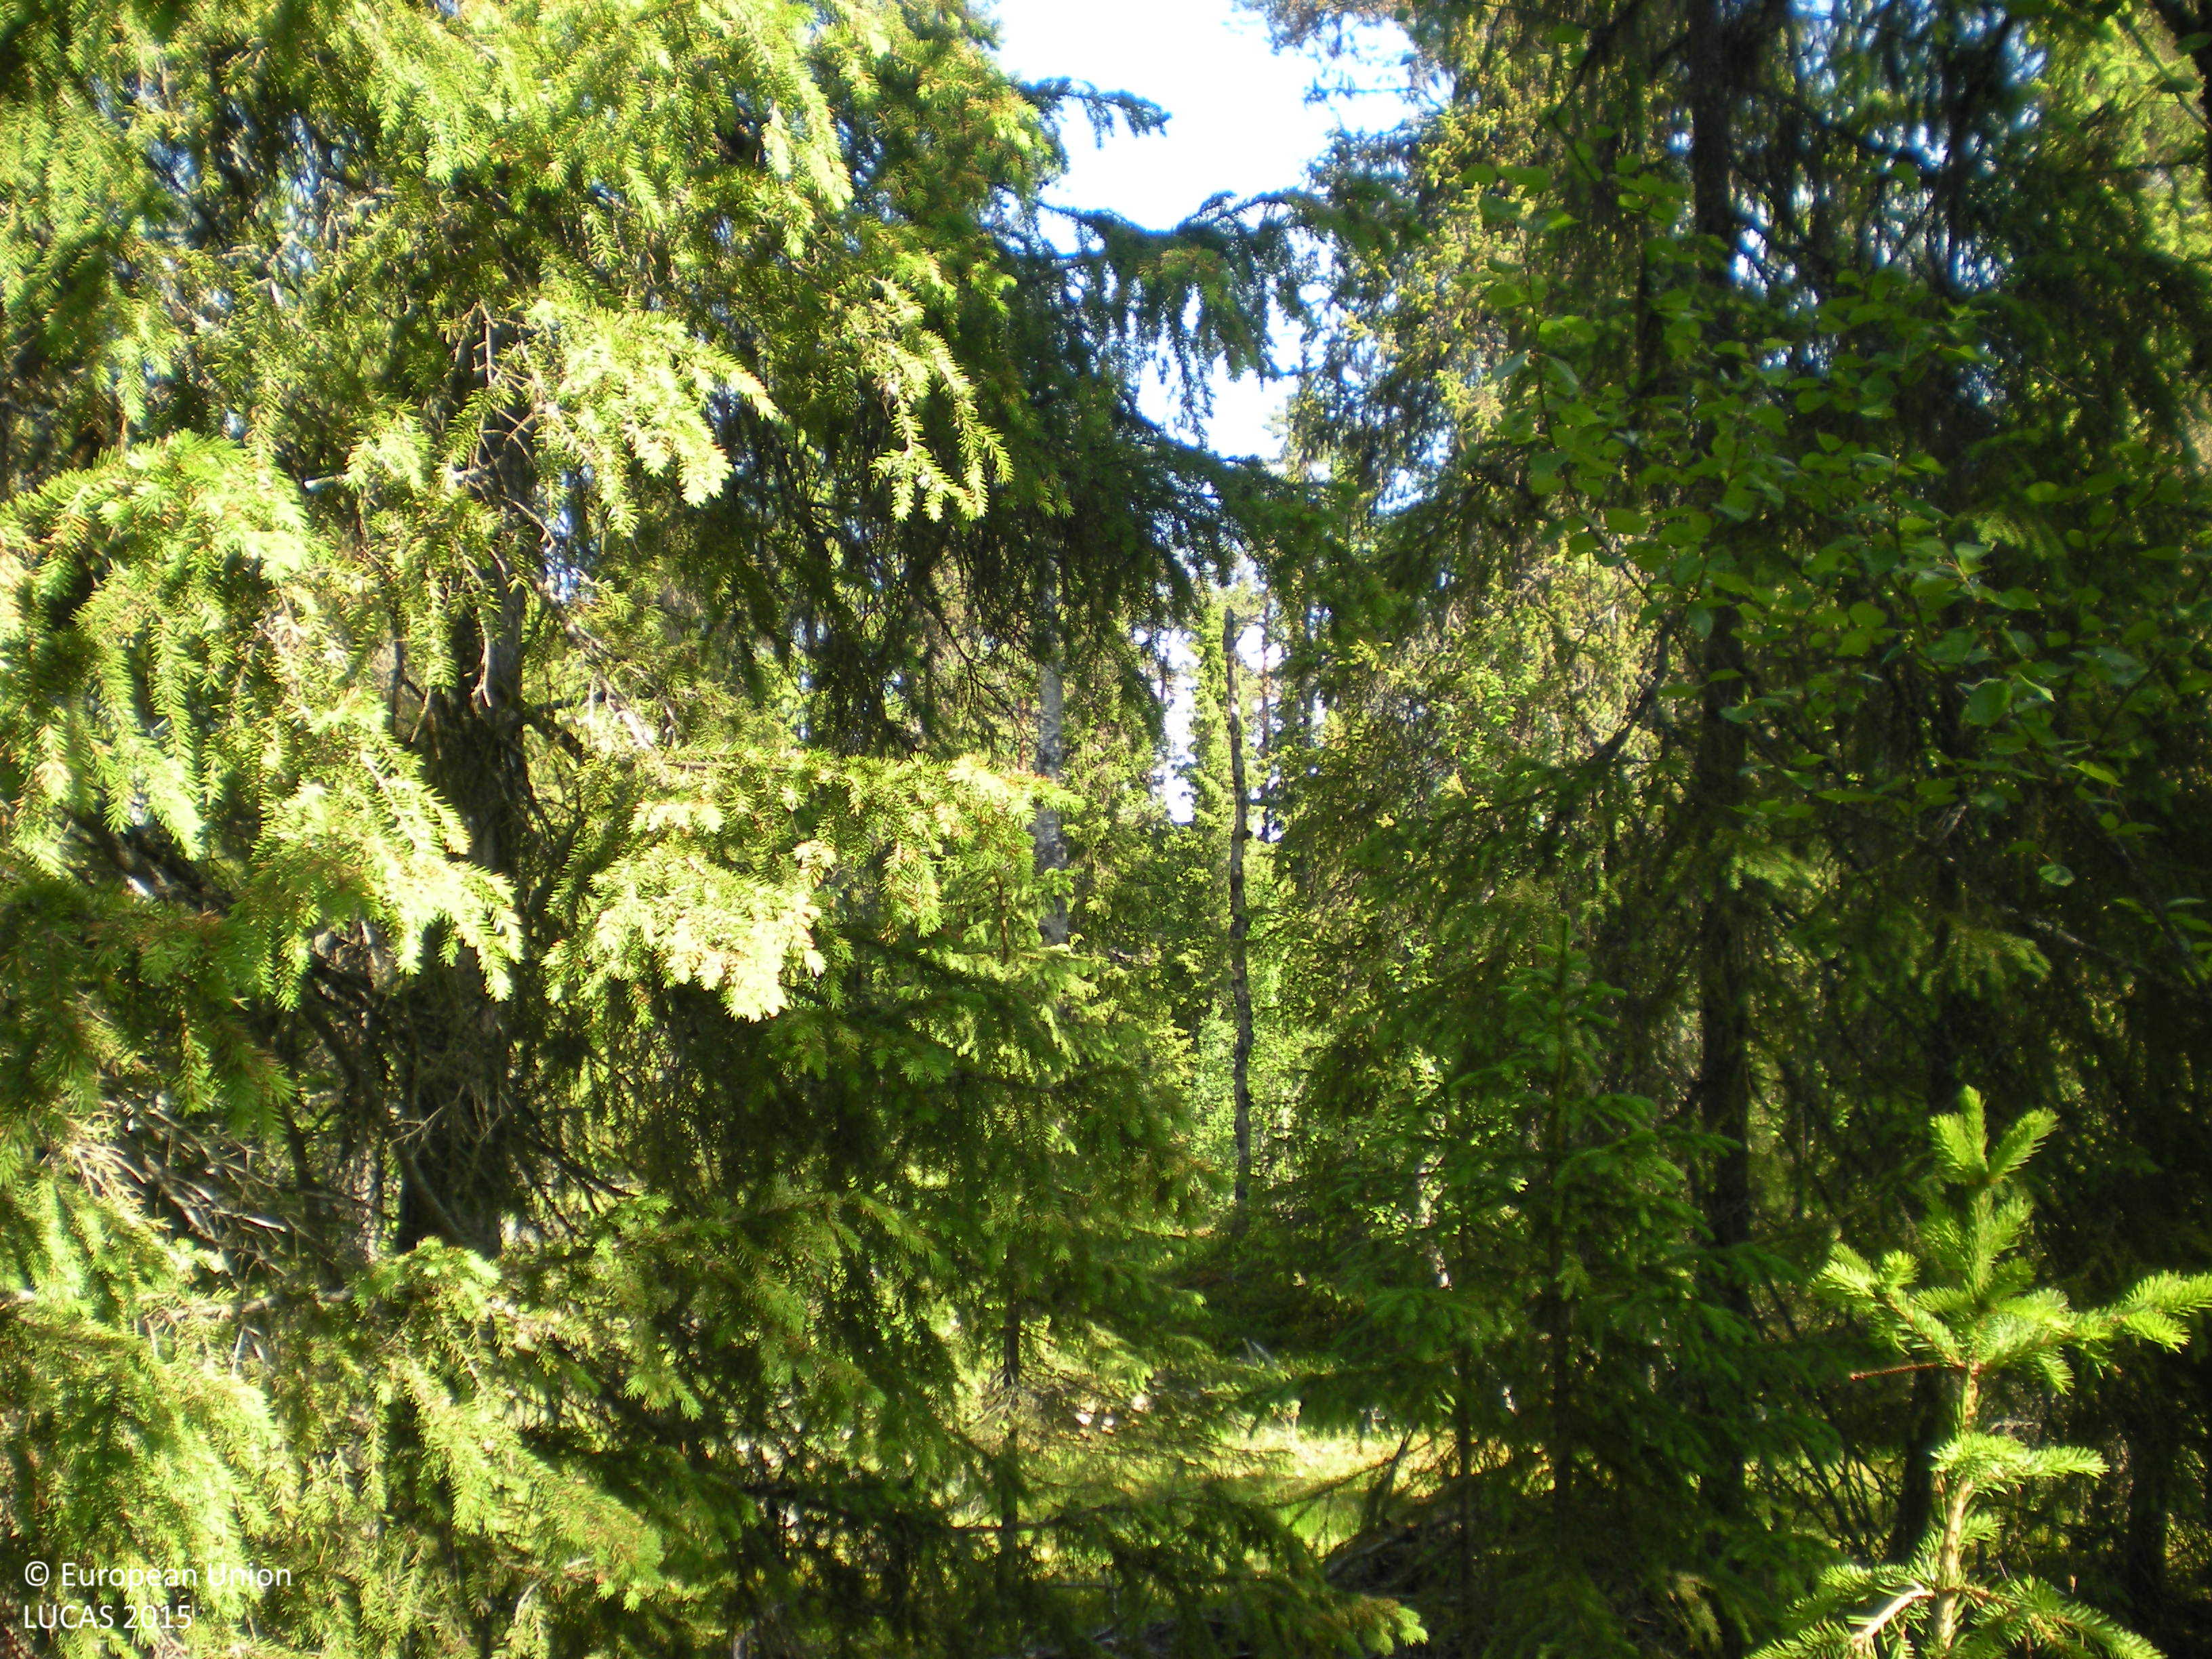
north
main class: Woodland
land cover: Spruce dominated mixed woodland
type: boreal forest
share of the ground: 50 - 75 %
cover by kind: coniferous forest trees 55 %, broadleaved forest trees 20 %, shrubs 10 %, lichens and mosses 10 %, herbaceous plants 5 %
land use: Semi-natural and natural areas not in use
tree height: > 5 m
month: July
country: SE
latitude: 65.6466
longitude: 16.4154
